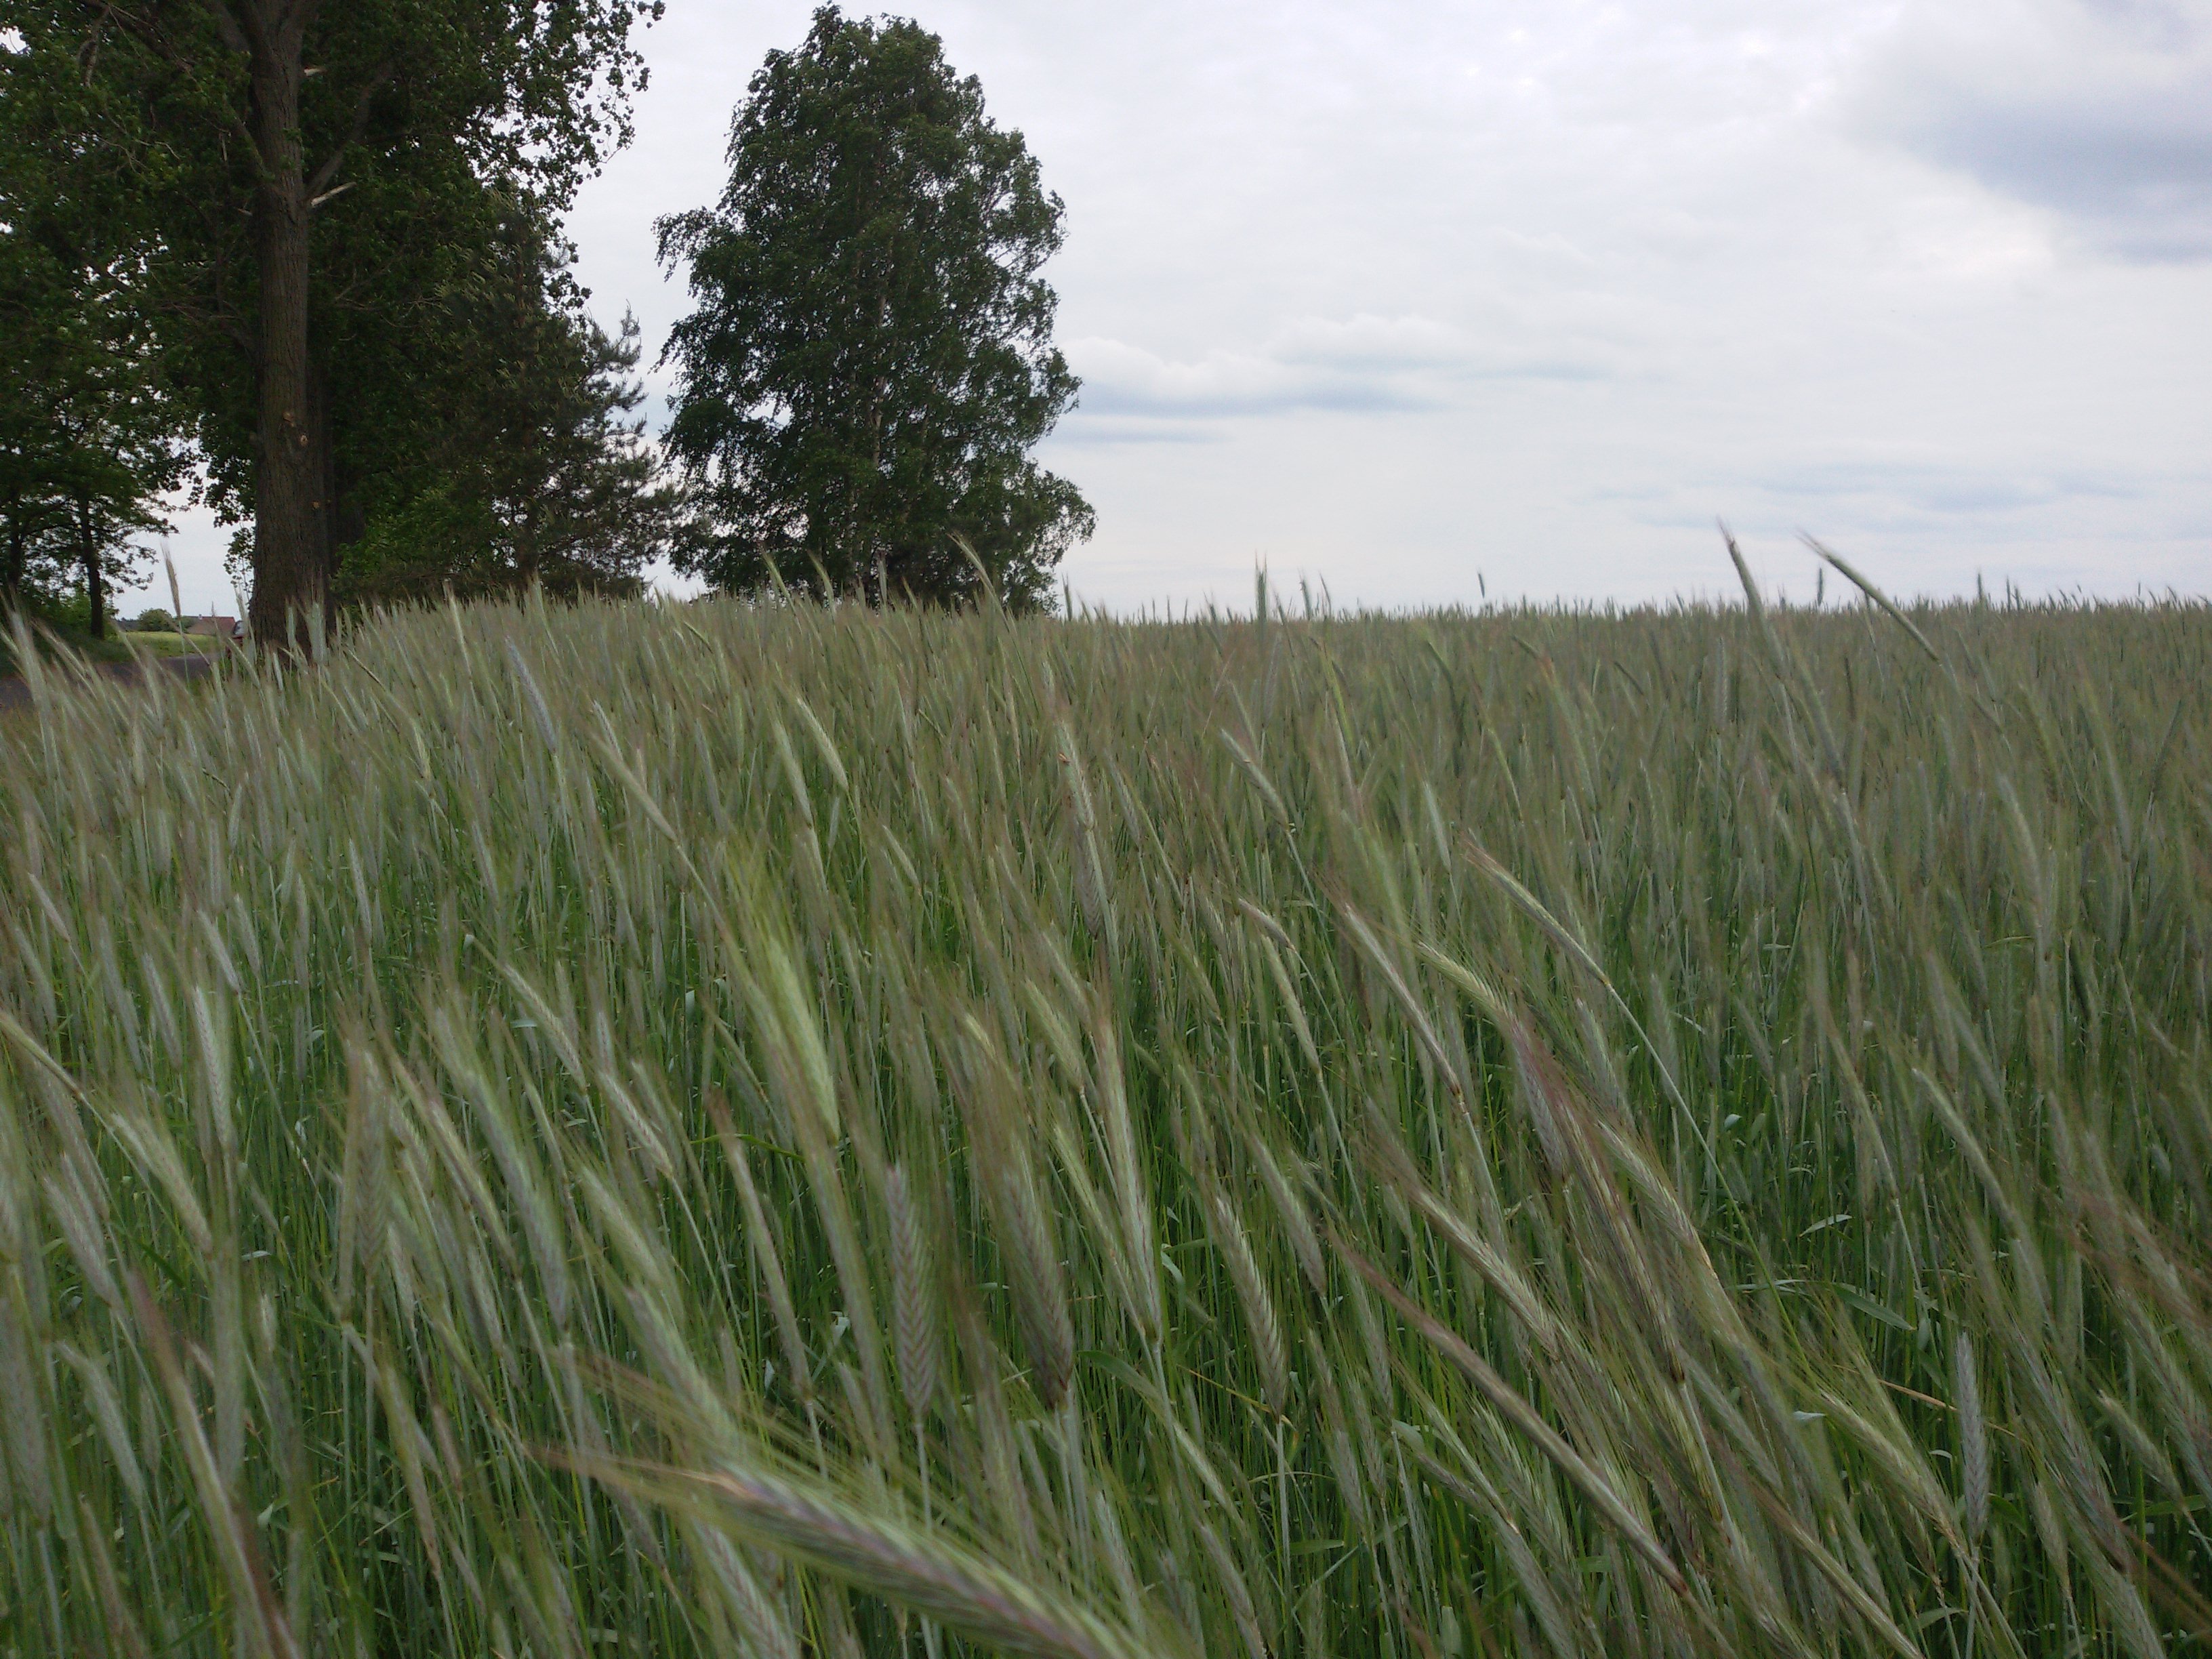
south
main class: Cropland
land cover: Rye
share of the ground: > 75 %
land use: Agriculture (excluding fallow land and kitchen gardens)
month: May
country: PL
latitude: 52.1273
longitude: 17.1243
